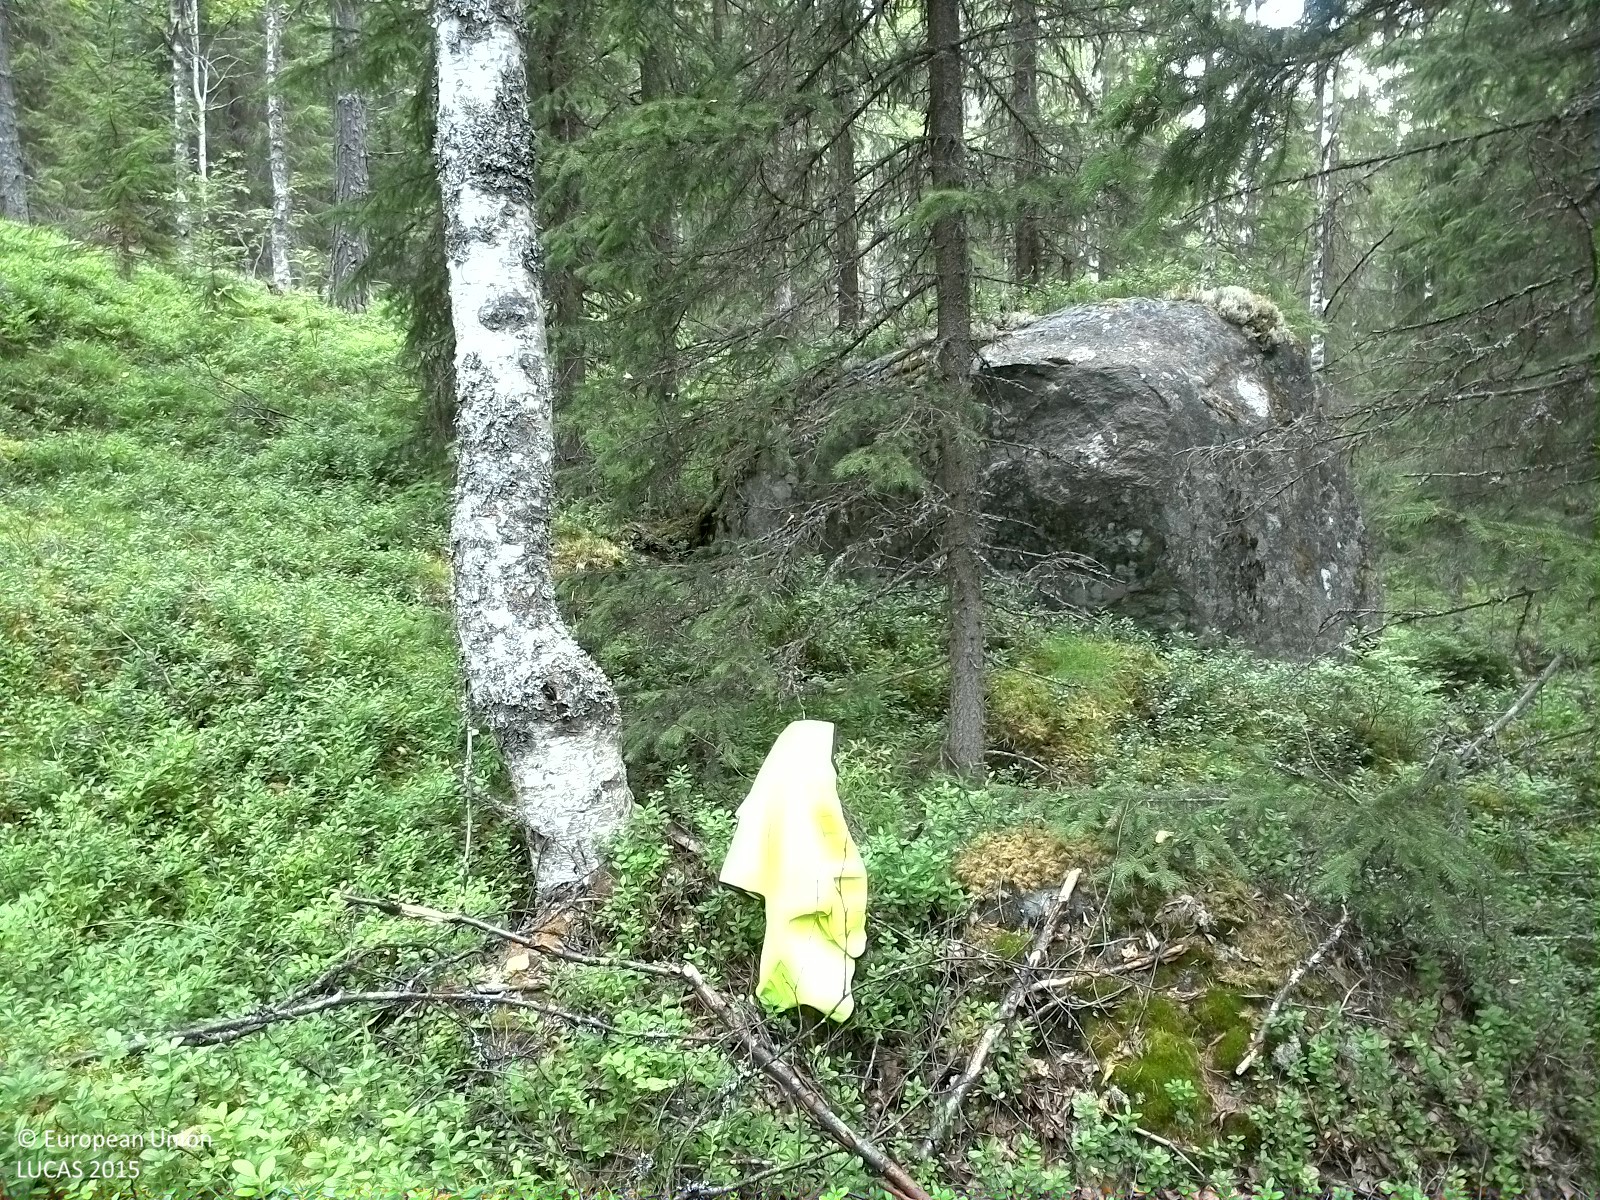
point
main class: Woodland
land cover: Other mixed woodland
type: boreal forest
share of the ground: 50 - 75 %
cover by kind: shrubs 45 %, coniferous forest trees 30 %, broadleaved forest trees 25 %
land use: Forestry
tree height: > 5 m
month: August
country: SE
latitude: 62.8138
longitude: 16.5498
